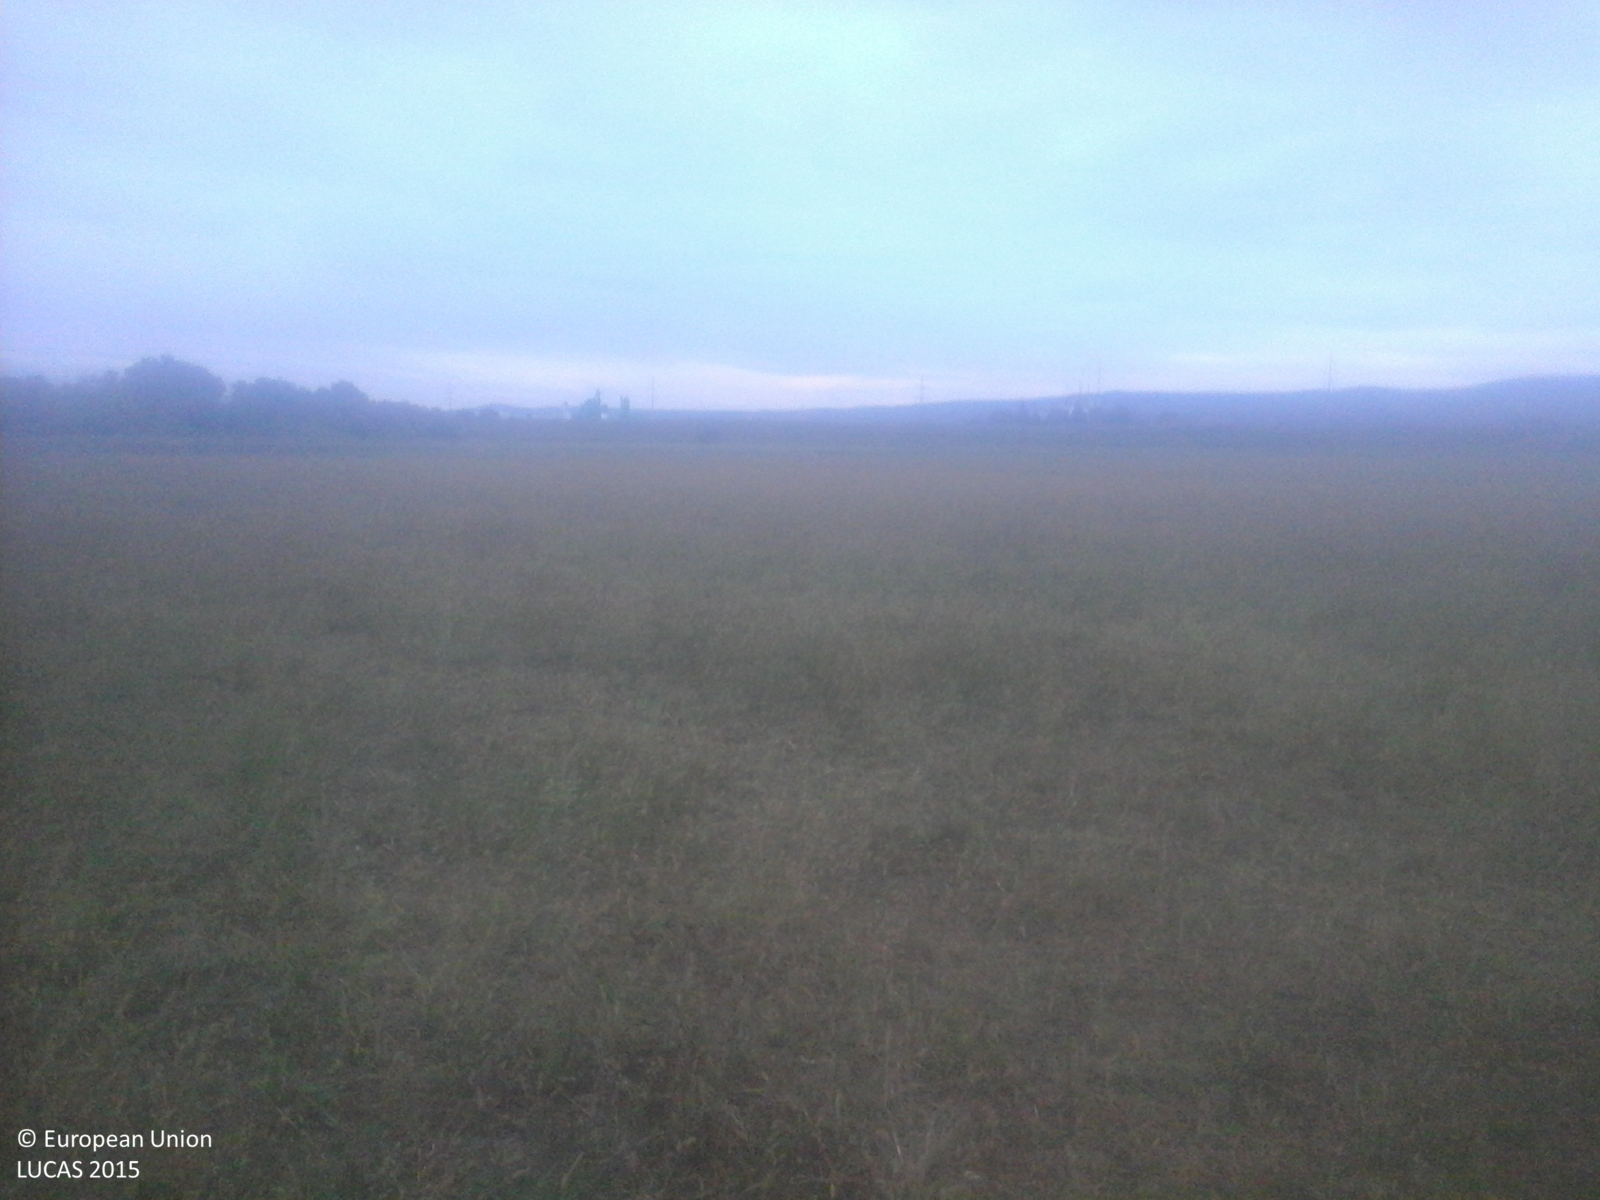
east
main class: Grassland
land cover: Spontaneously vegetated surfaces
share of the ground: > 75 %
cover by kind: herbaceous plants 100 %
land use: Fallow land
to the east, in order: Spontaneously vegetated surfaces; Tracks; Sunflower
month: September
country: RO
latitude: 46.0185
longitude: 23.5111
